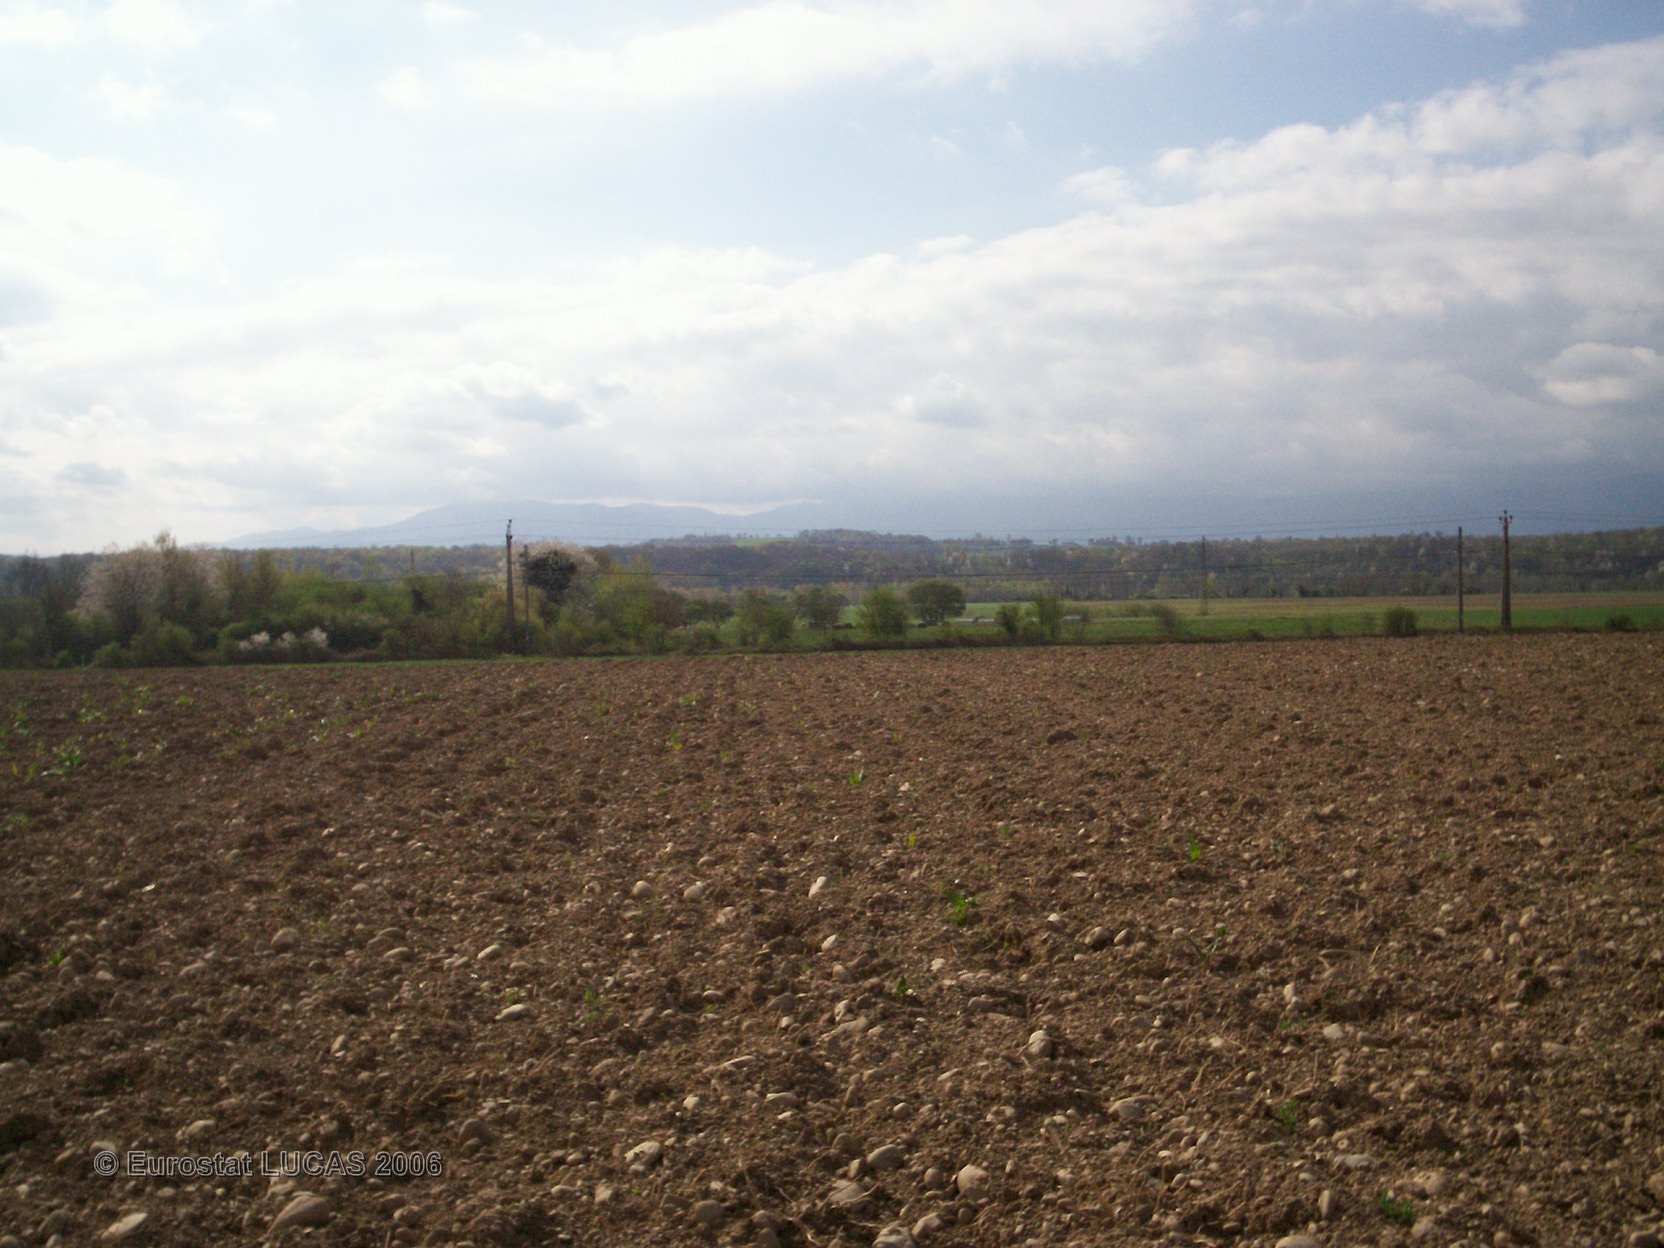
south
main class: Cropland
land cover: Other fibre and oleaginous crops
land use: Agriculture (excluding fallow land and kitchen gardens)
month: June
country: FR
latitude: 43.1149
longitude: 0.8961
